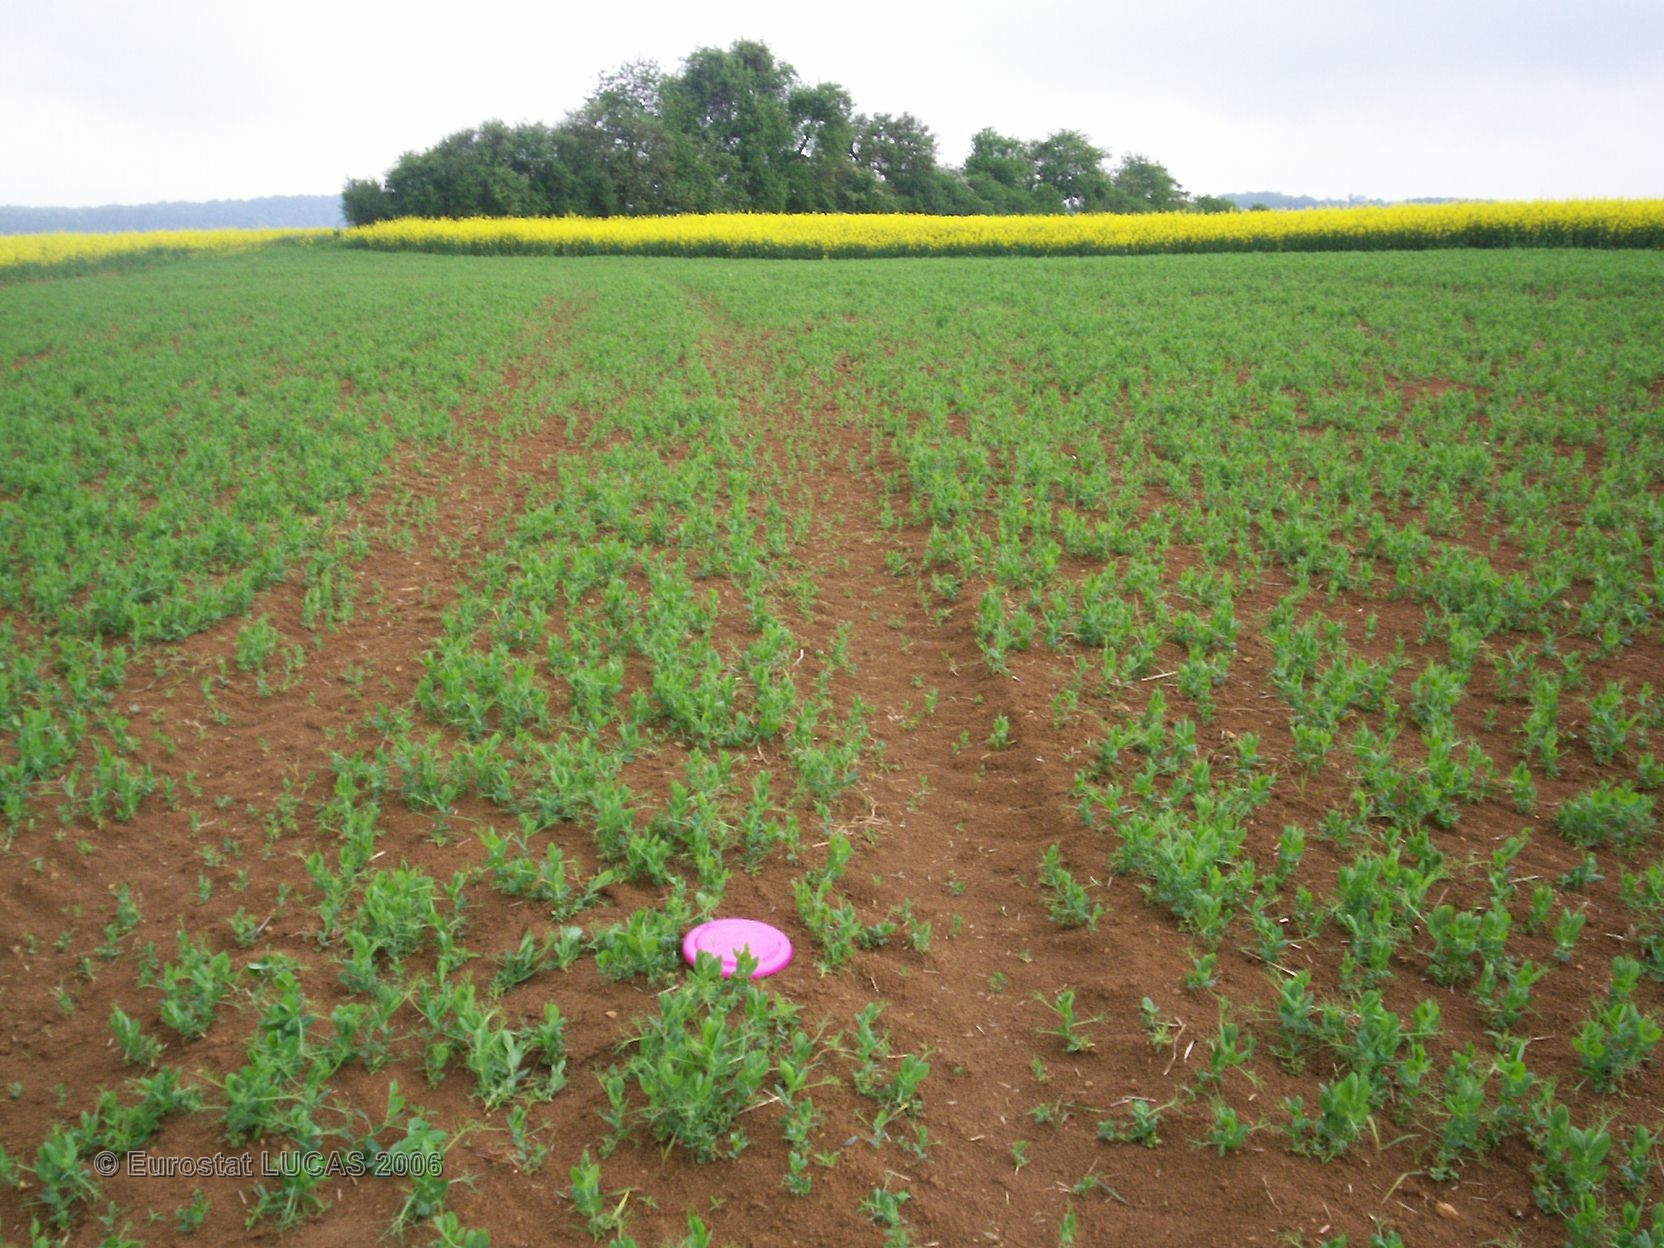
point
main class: Cropland
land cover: Dry pulses
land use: Agriculture (excluding fallow land and kitchen gardens)
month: May
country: FR
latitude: 49.4254
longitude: 6.4014
